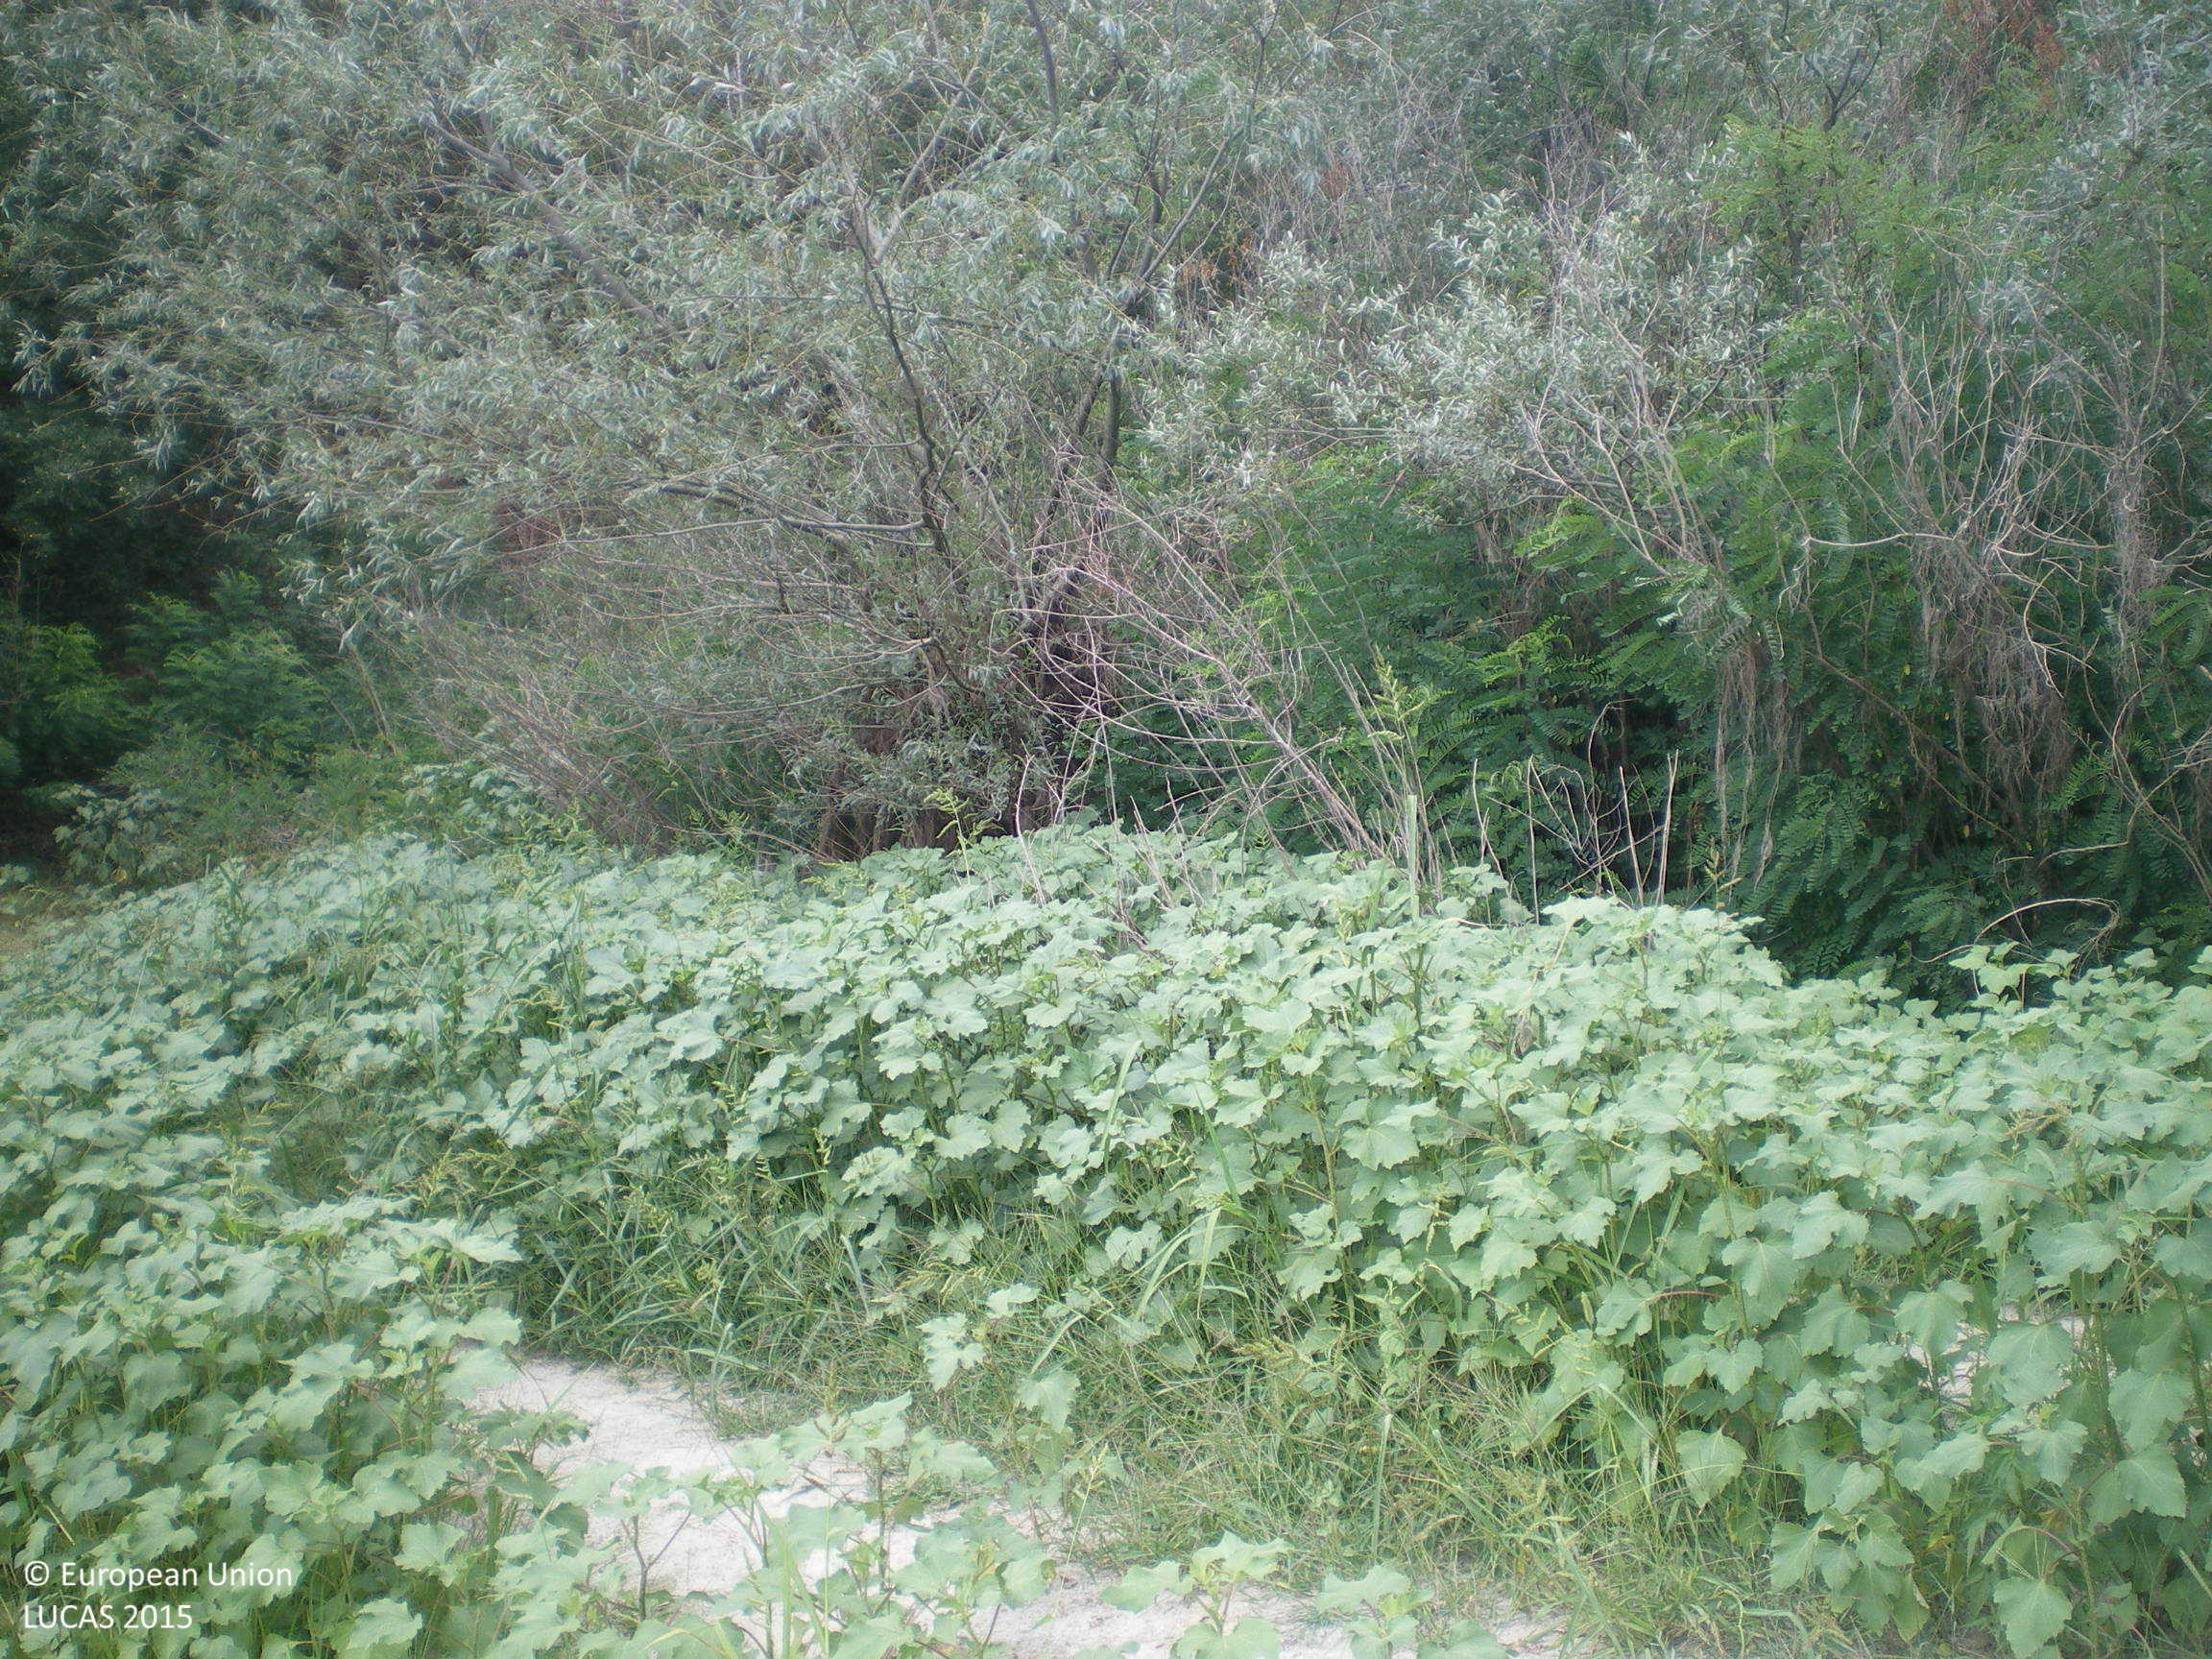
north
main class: Grassland
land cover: Spontaneously vegetated surfaces
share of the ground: > 75 %
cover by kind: herbaceous plants 60 %, unconsolidated bare surface 40 %
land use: Abandoned areas
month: August
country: BG
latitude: 42.6218
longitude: 25.2955
